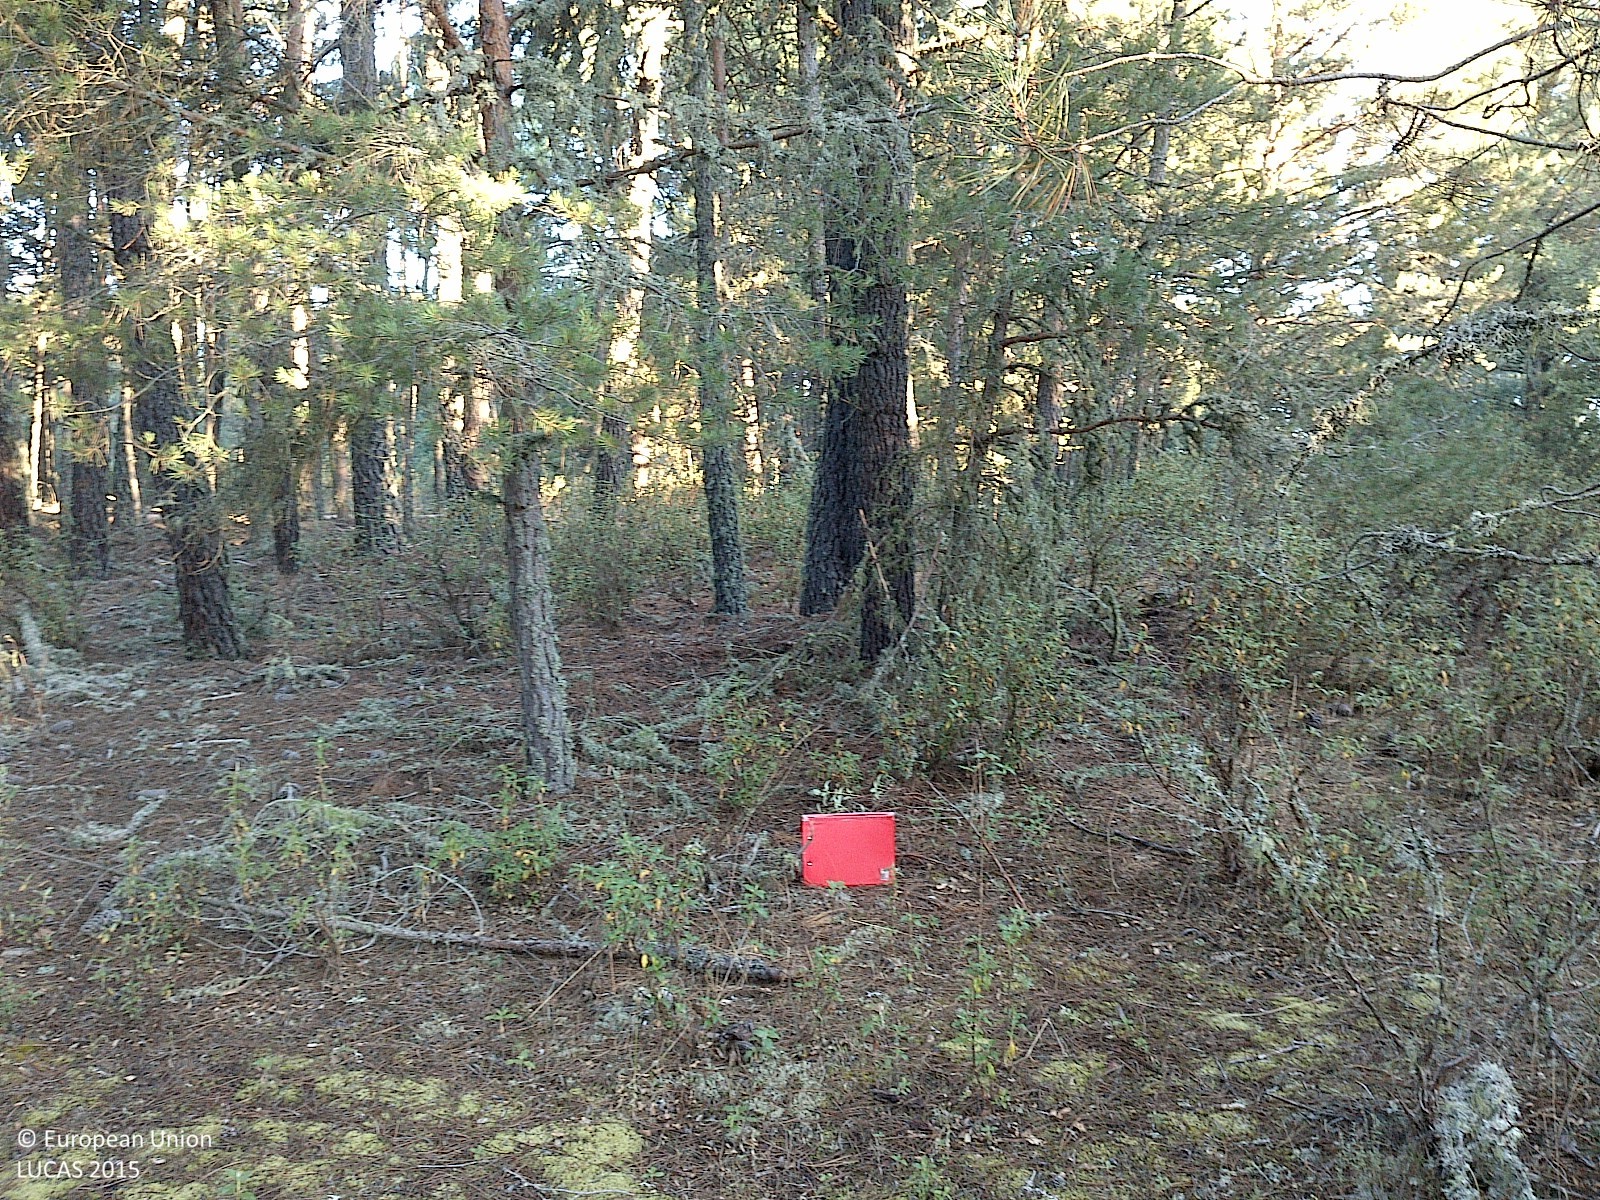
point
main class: Woodland
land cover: Pine dominated coniferous woodland
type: coniferous forest of the mediterranean region
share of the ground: > 75 %
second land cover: Grassland without tree/shrub cover
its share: 10 - 25 %
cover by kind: coniferous forest trees 80 %, herbaceous plants 10 %, shrubs 5 %, lichens and mosses 5 %
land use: Forestry
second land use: Agriculture (excluding fallow land and kitchen gardens)
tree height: > 5 m
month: July
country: ES
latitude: 41.8519
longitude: -3.1156
